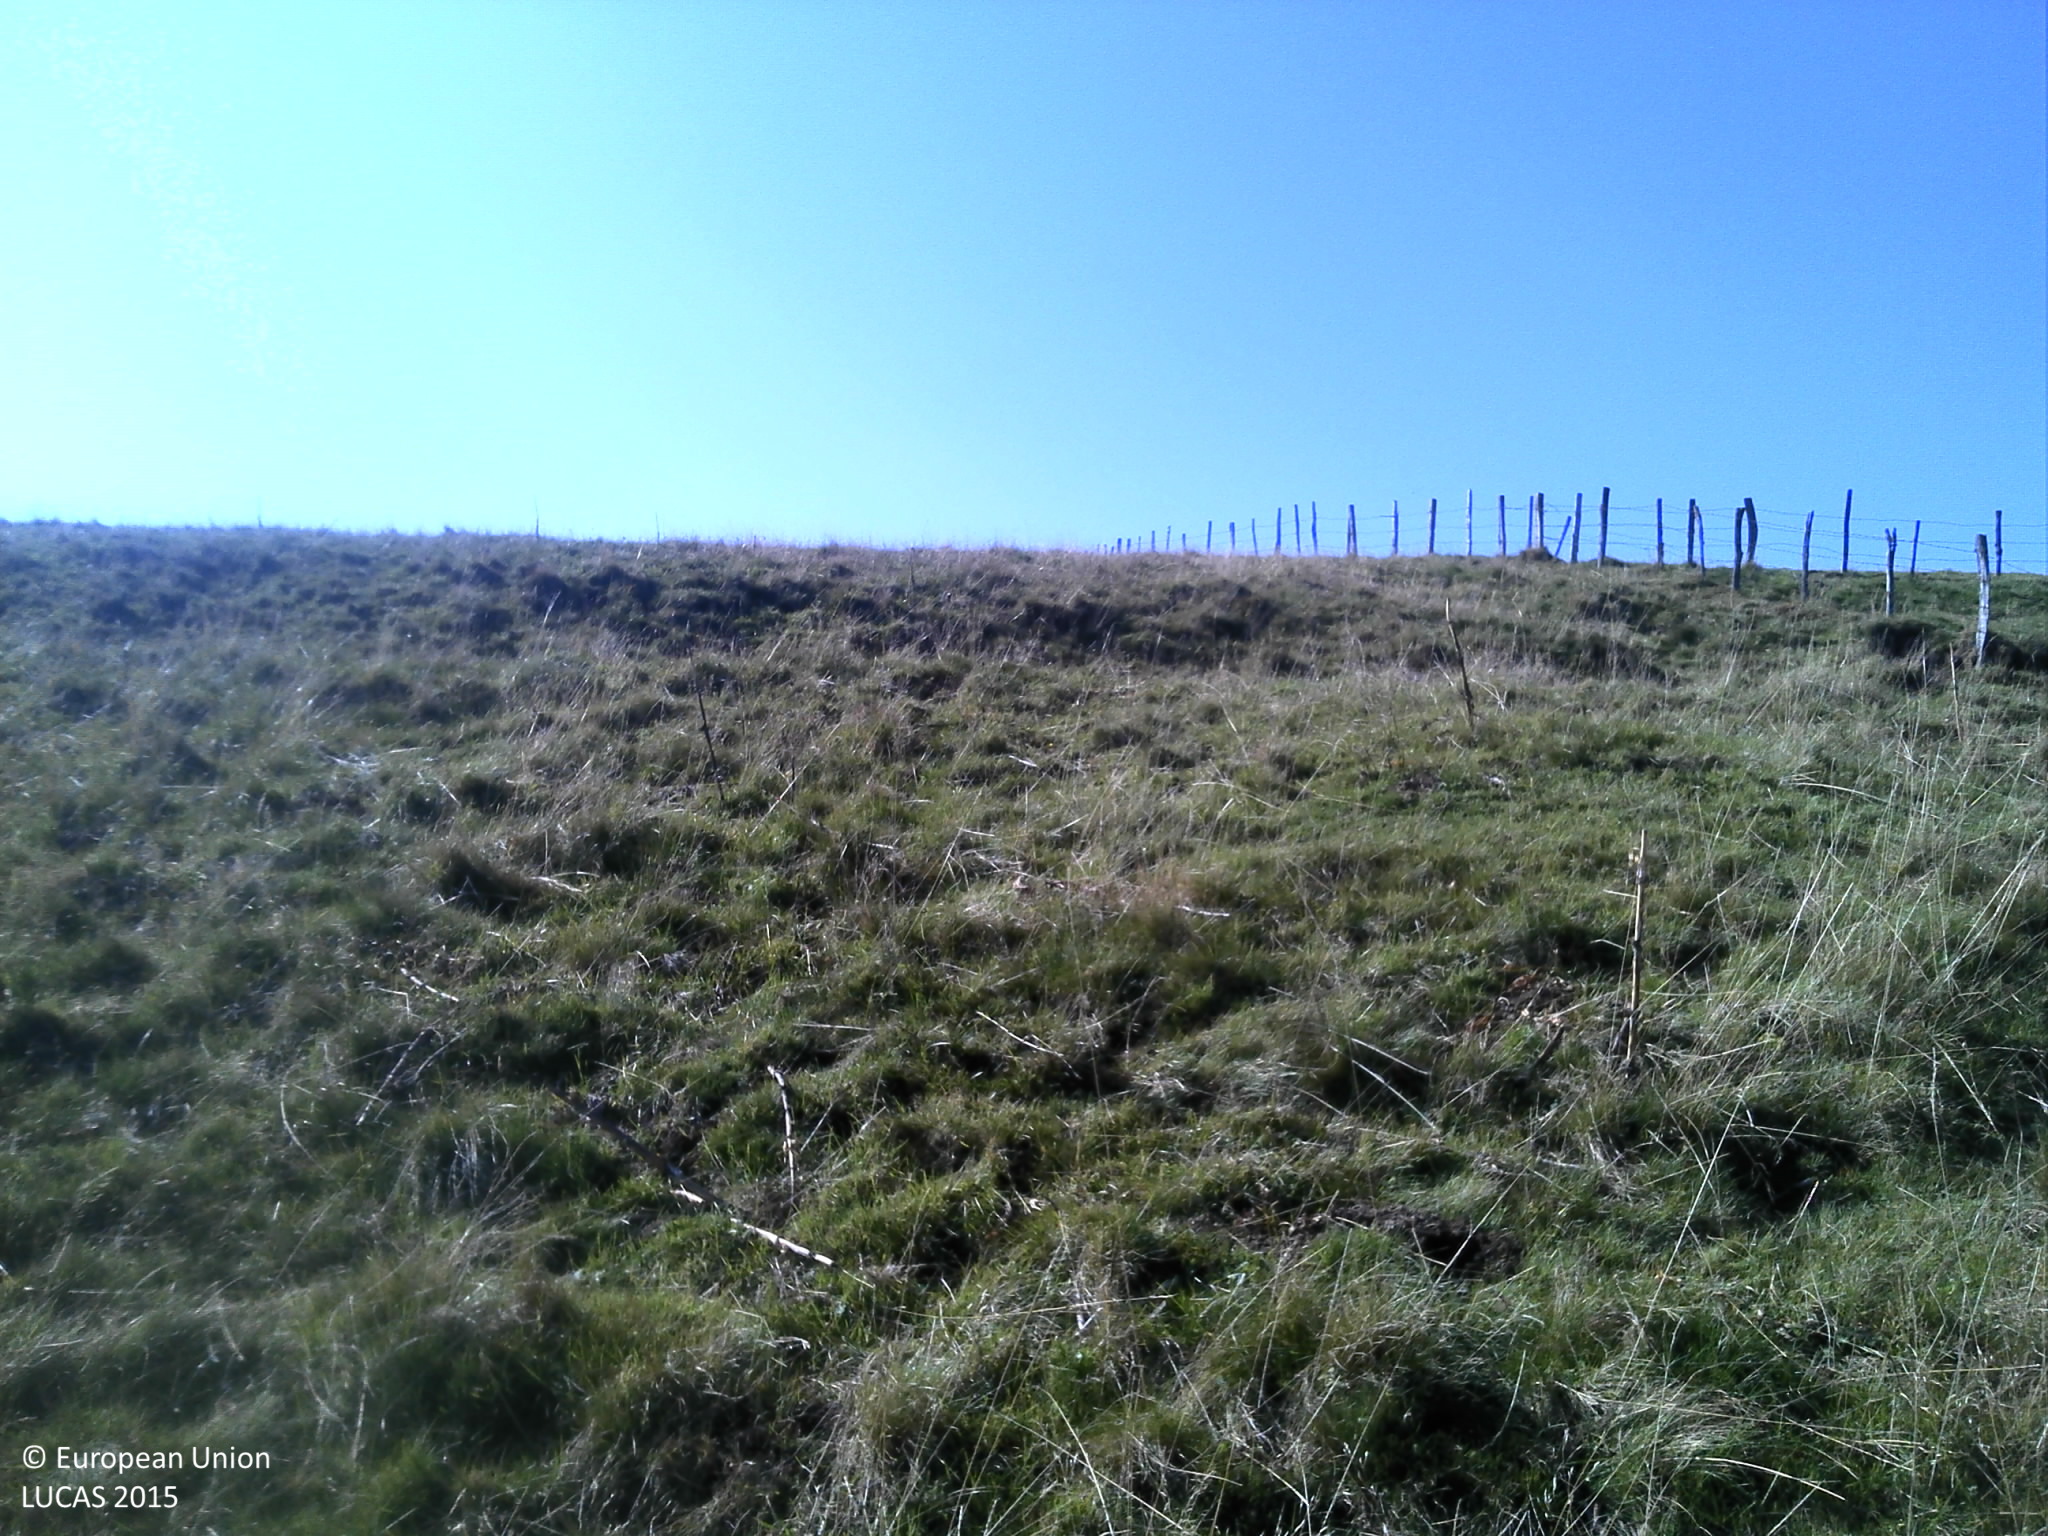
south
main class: Grassland
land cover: Grassland without tree/shrub cover
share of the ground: > 75 %
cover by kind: herbaceous plants 100 %
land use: Agriculture (excluding fallow land and kitchen gardens)
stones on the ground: < 10 %
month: October
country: FR
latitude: 45.4284
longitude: 2.9066
